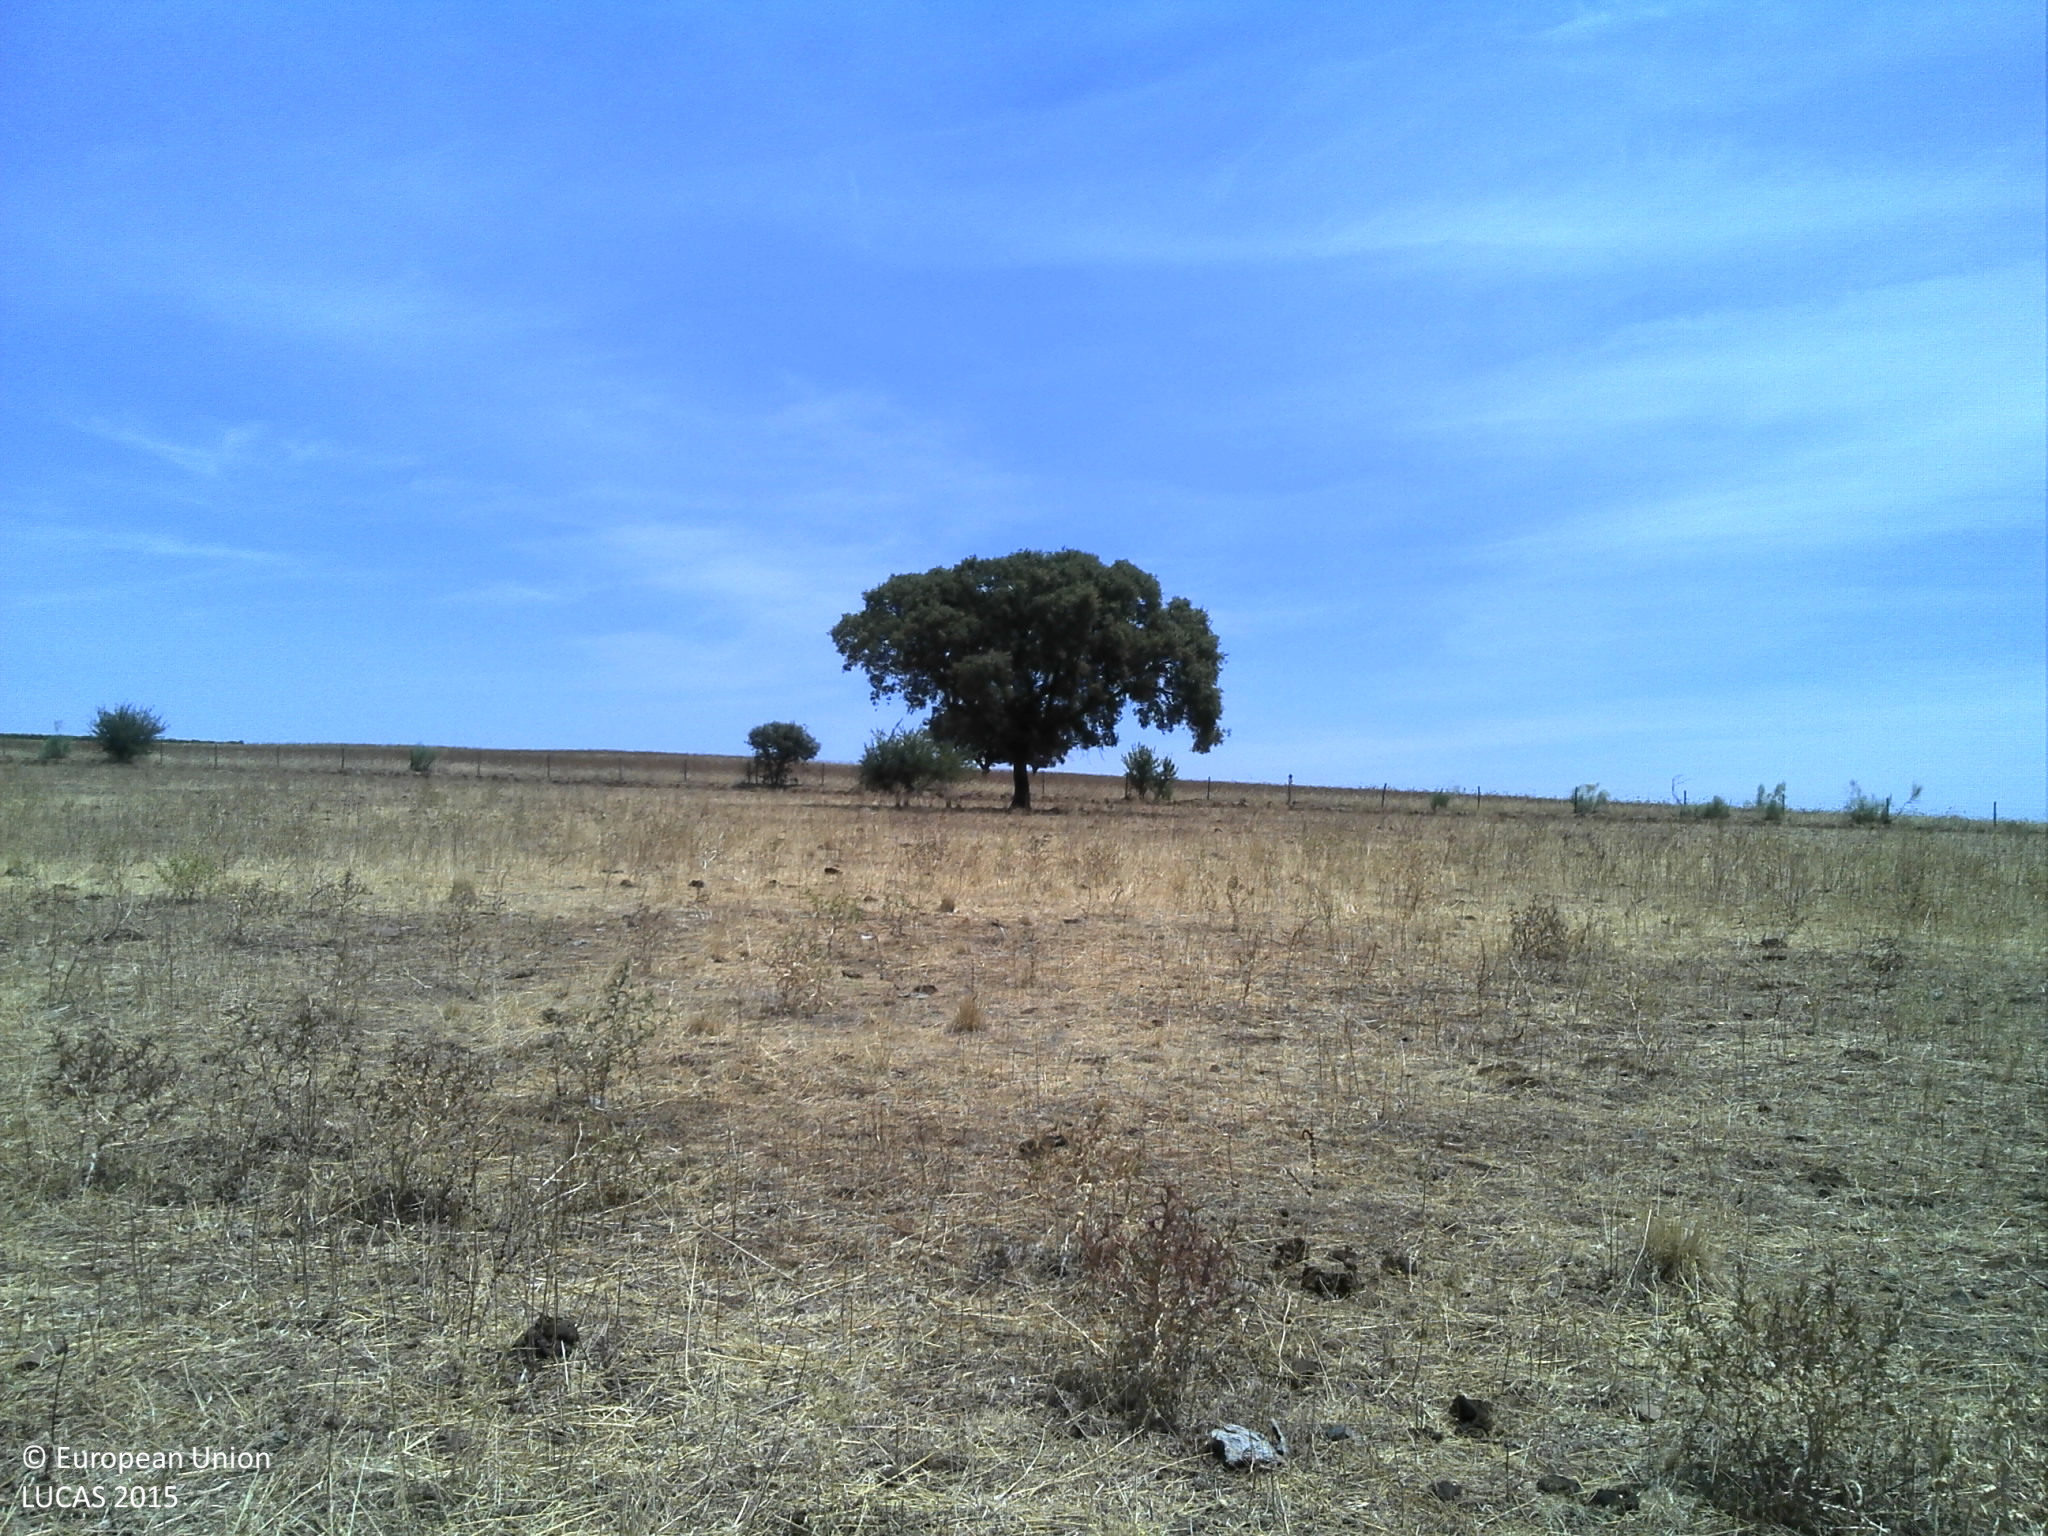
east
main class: Grassland
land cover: Spontaneously vegetated surfaces
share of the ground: 10 - 25 %
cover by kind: unconsolidated bare surface 90 %, herbaceous plants 10 %
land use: Agriculture (excluding fallow land and kitchen gardens)
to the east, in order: Spontaneously vegetated surfaces; Other bare soil; Grass margins; Fences; Spontaneously vegetated surfaces
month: July
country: PT
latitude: 38.3743
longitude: -7.4583
